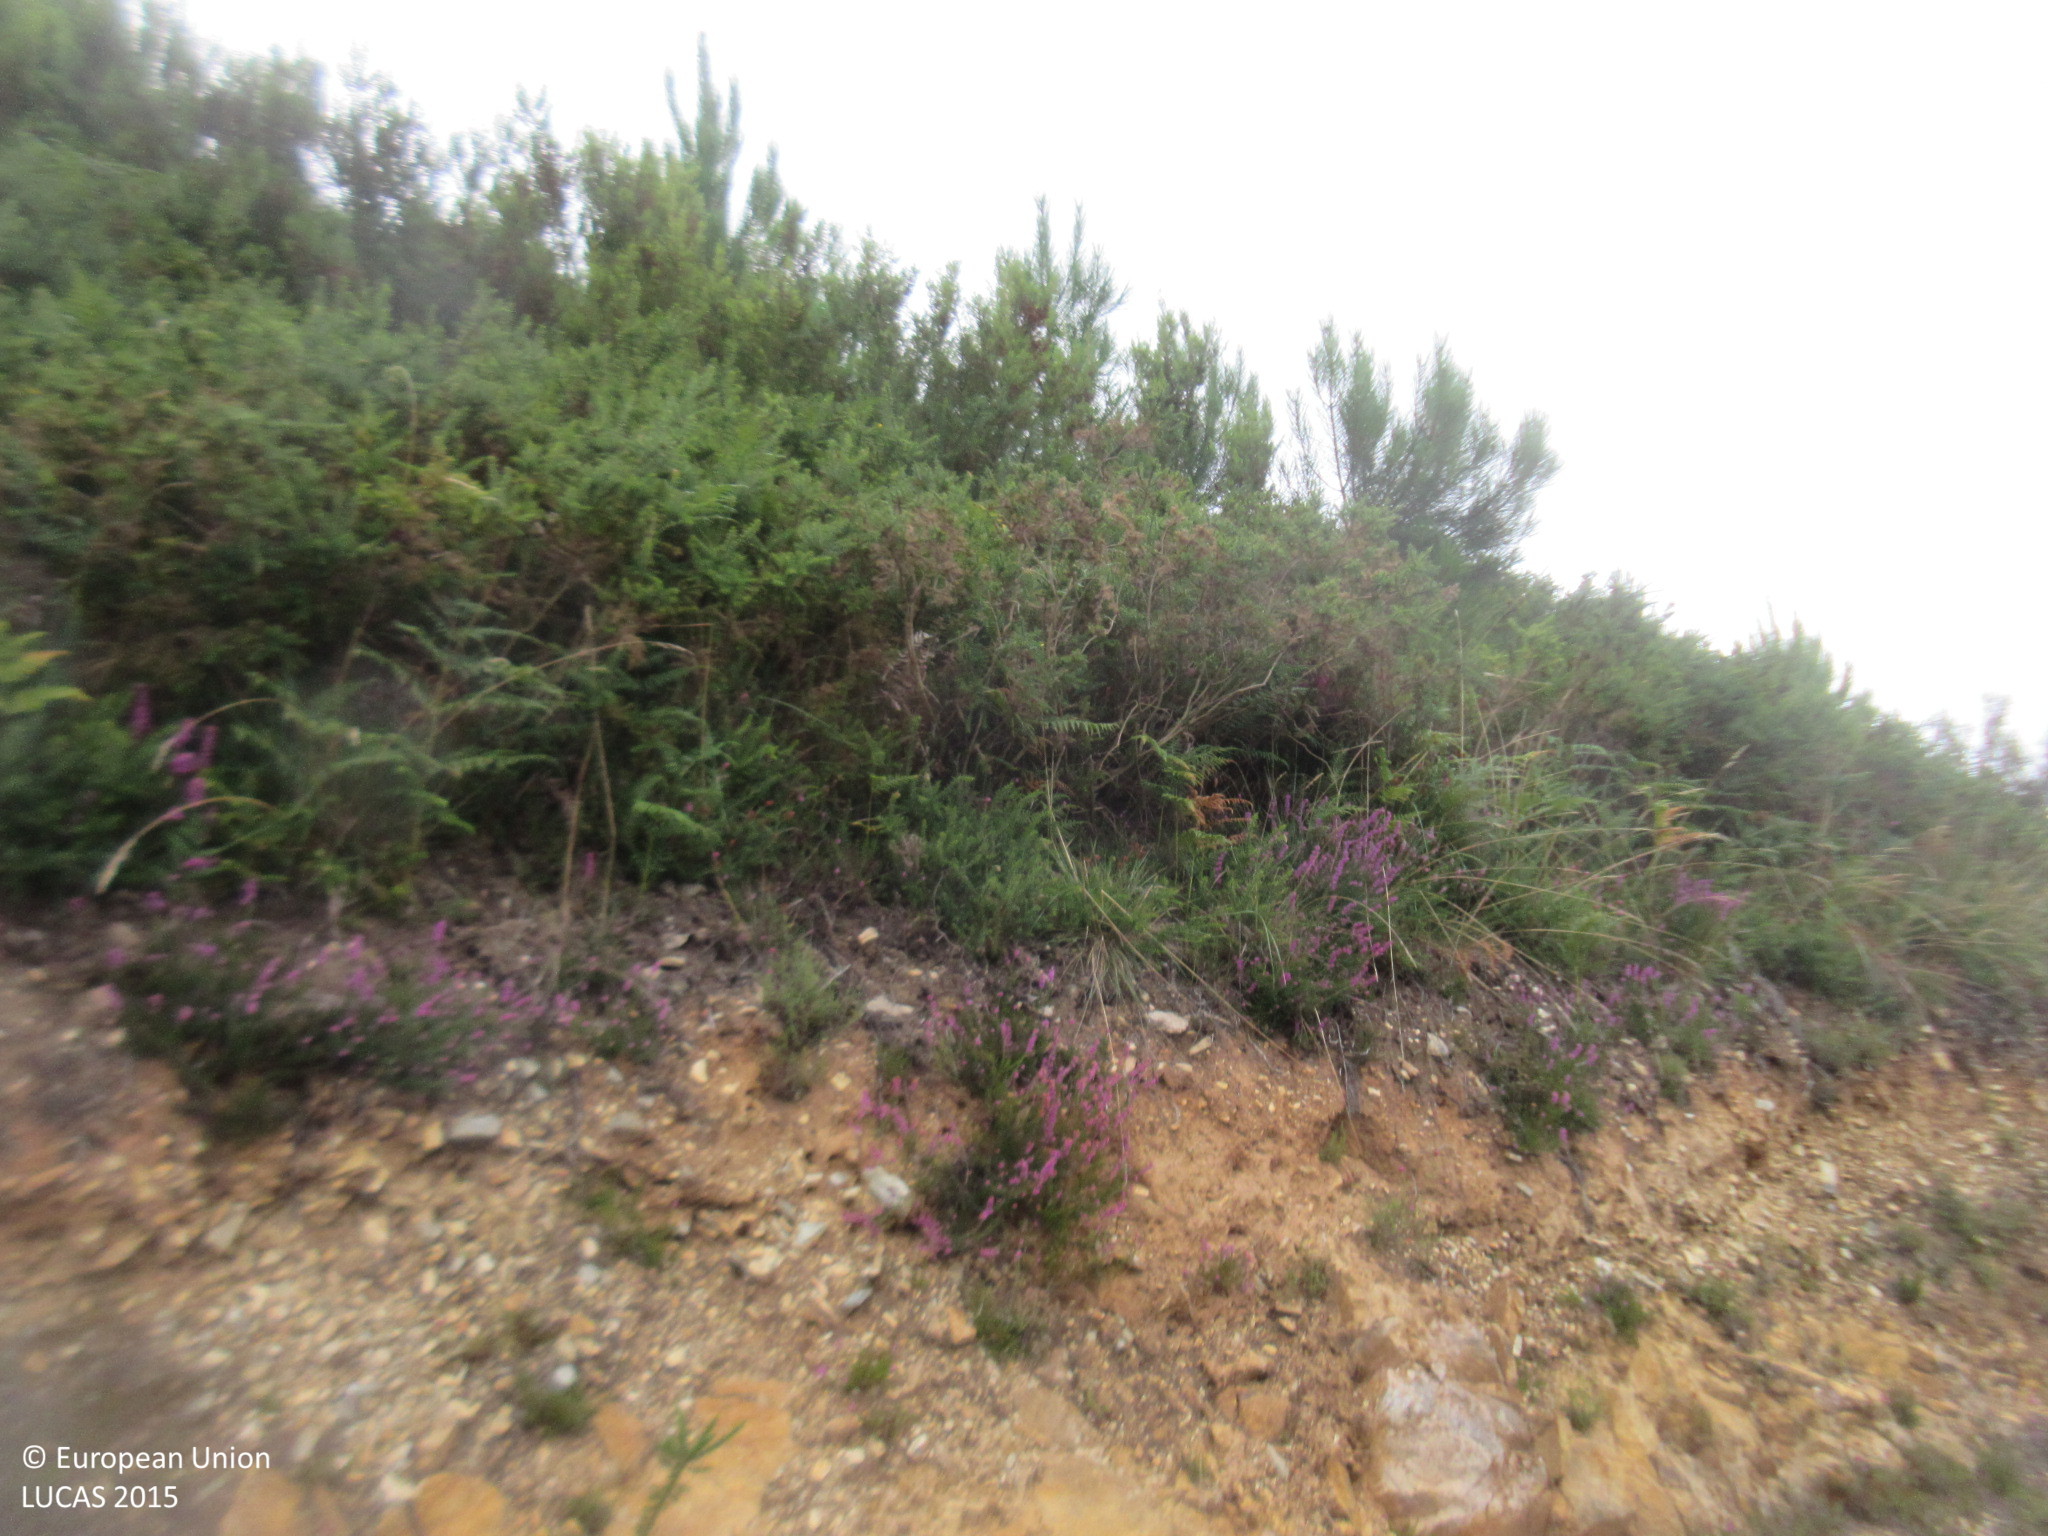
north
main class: Woodland
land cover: Pine dominated coniferous woodland
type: hemiboreal forest and nemoral coniferous forest and mixed broadleaved-coniferous forest
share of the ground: 50 - 75 %
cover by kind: coniferous forest trees 50 %, shrubs 50 %
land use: Forestry
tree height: > 5 m
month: August
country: ES
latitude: 43.4260
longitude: -6.3687
